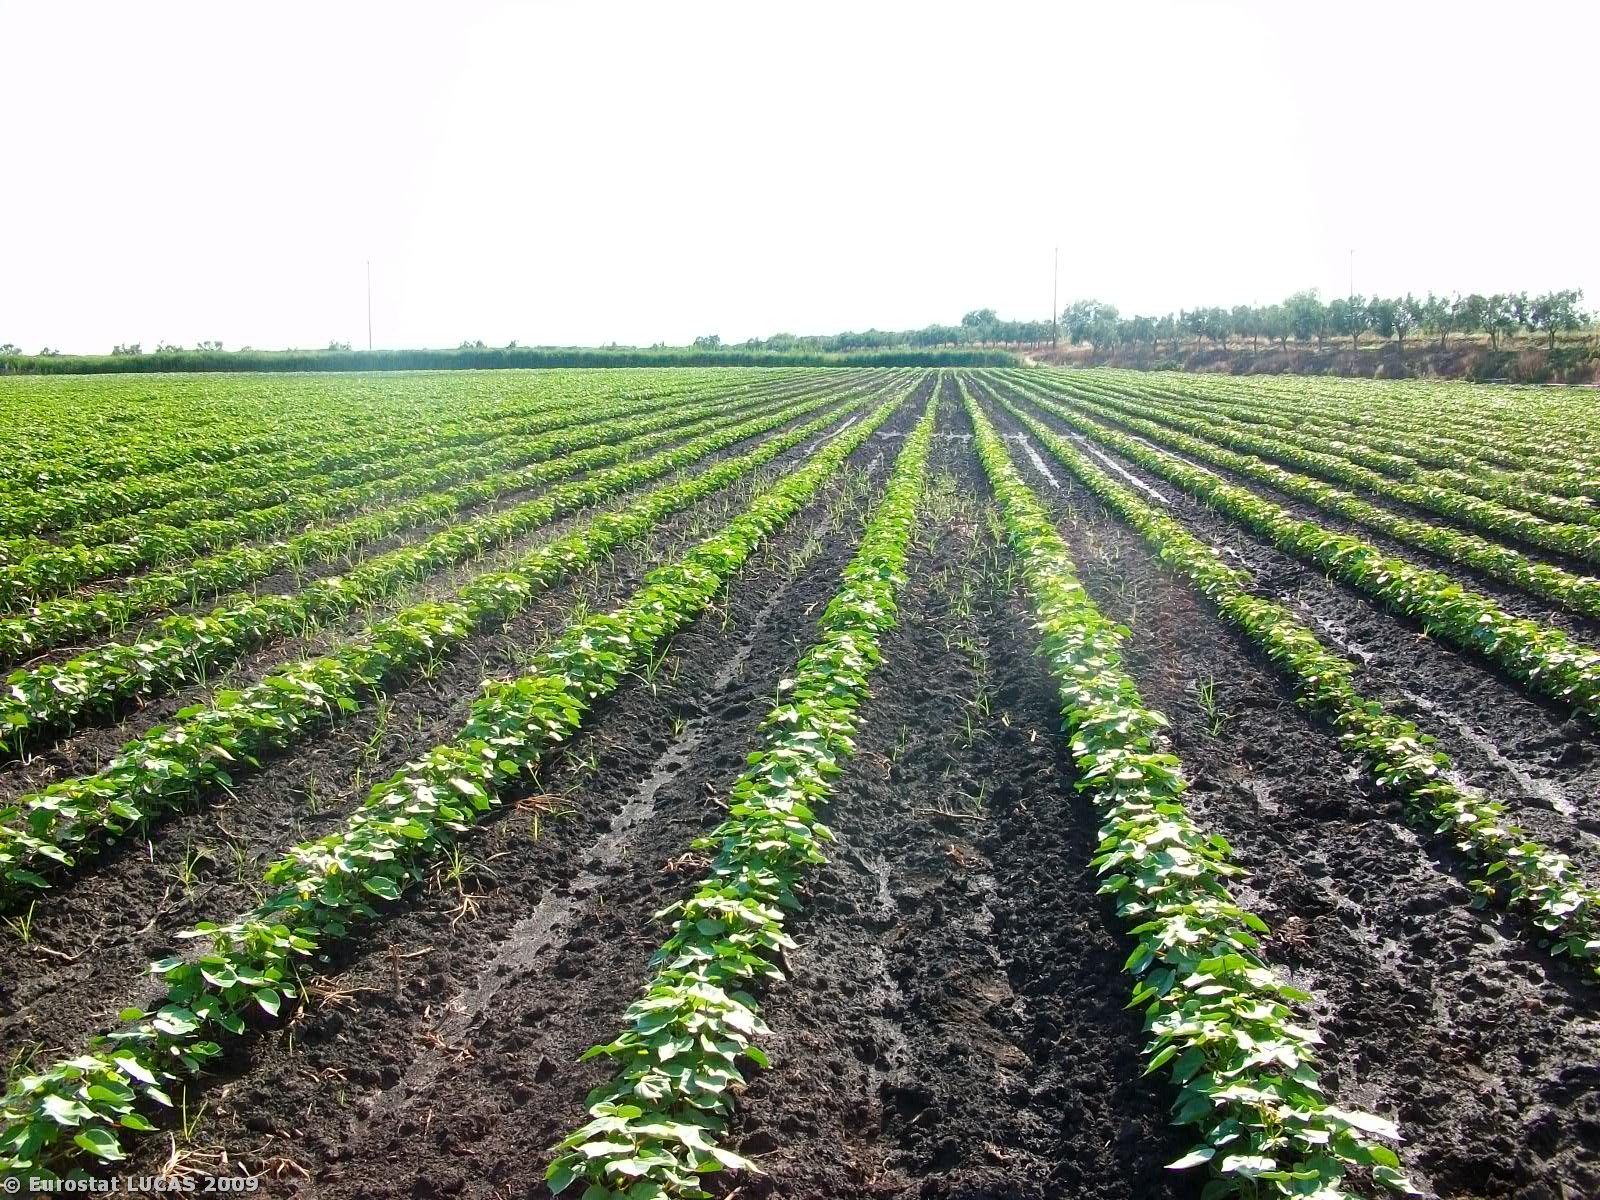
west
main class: Cropland
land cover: Cotton
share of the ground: 25 - 50 %
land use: Agriculture (excluding fallow land and kitchen gardens)
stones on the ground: < 10 %
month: June
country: GR
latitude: 38.3654
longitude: 21.4926
